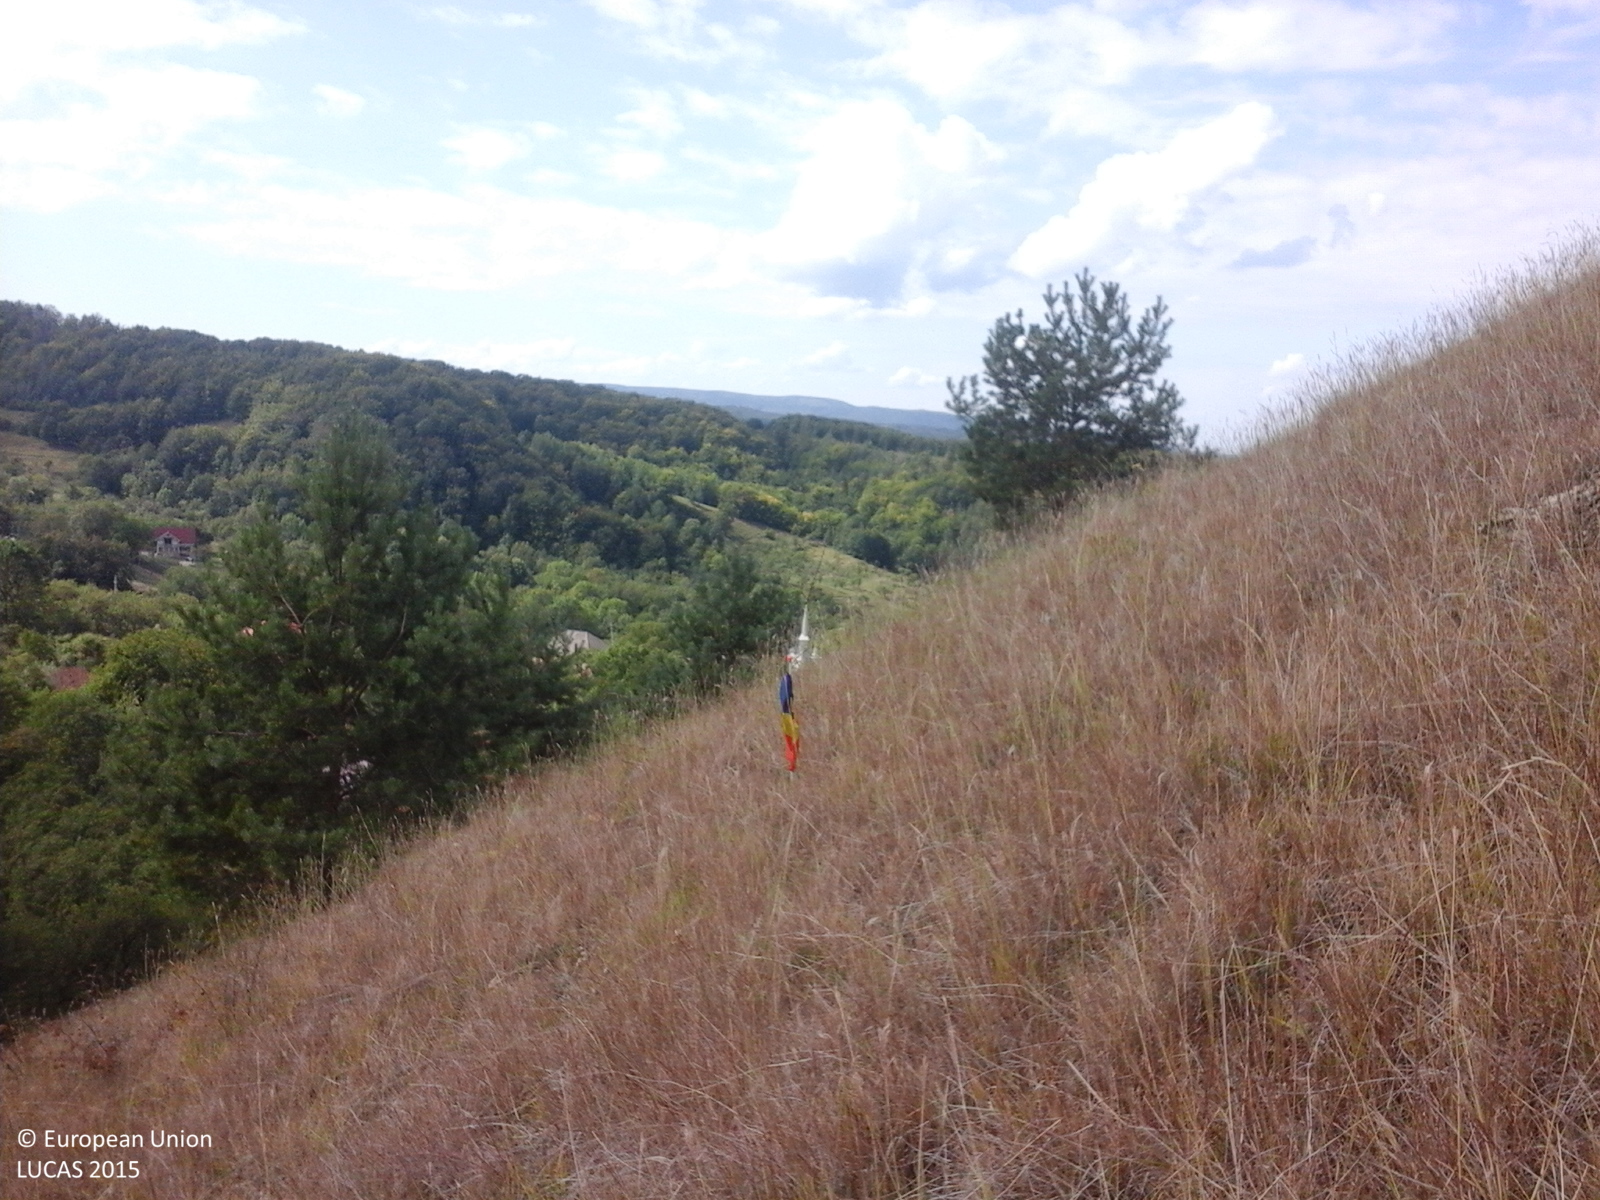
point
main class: Grassland
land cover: Grassland with sparse tree/shrub cover
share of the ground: > 75 %
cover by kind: herbaceous plants 85 %, shrubs 10 %, broadleaved forest trees 5 %
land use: Agriculture (excluding fallow land and kitchen gardens)
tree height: < 5 m
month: September
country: RO
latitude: 47.4600
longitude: 23.5114
